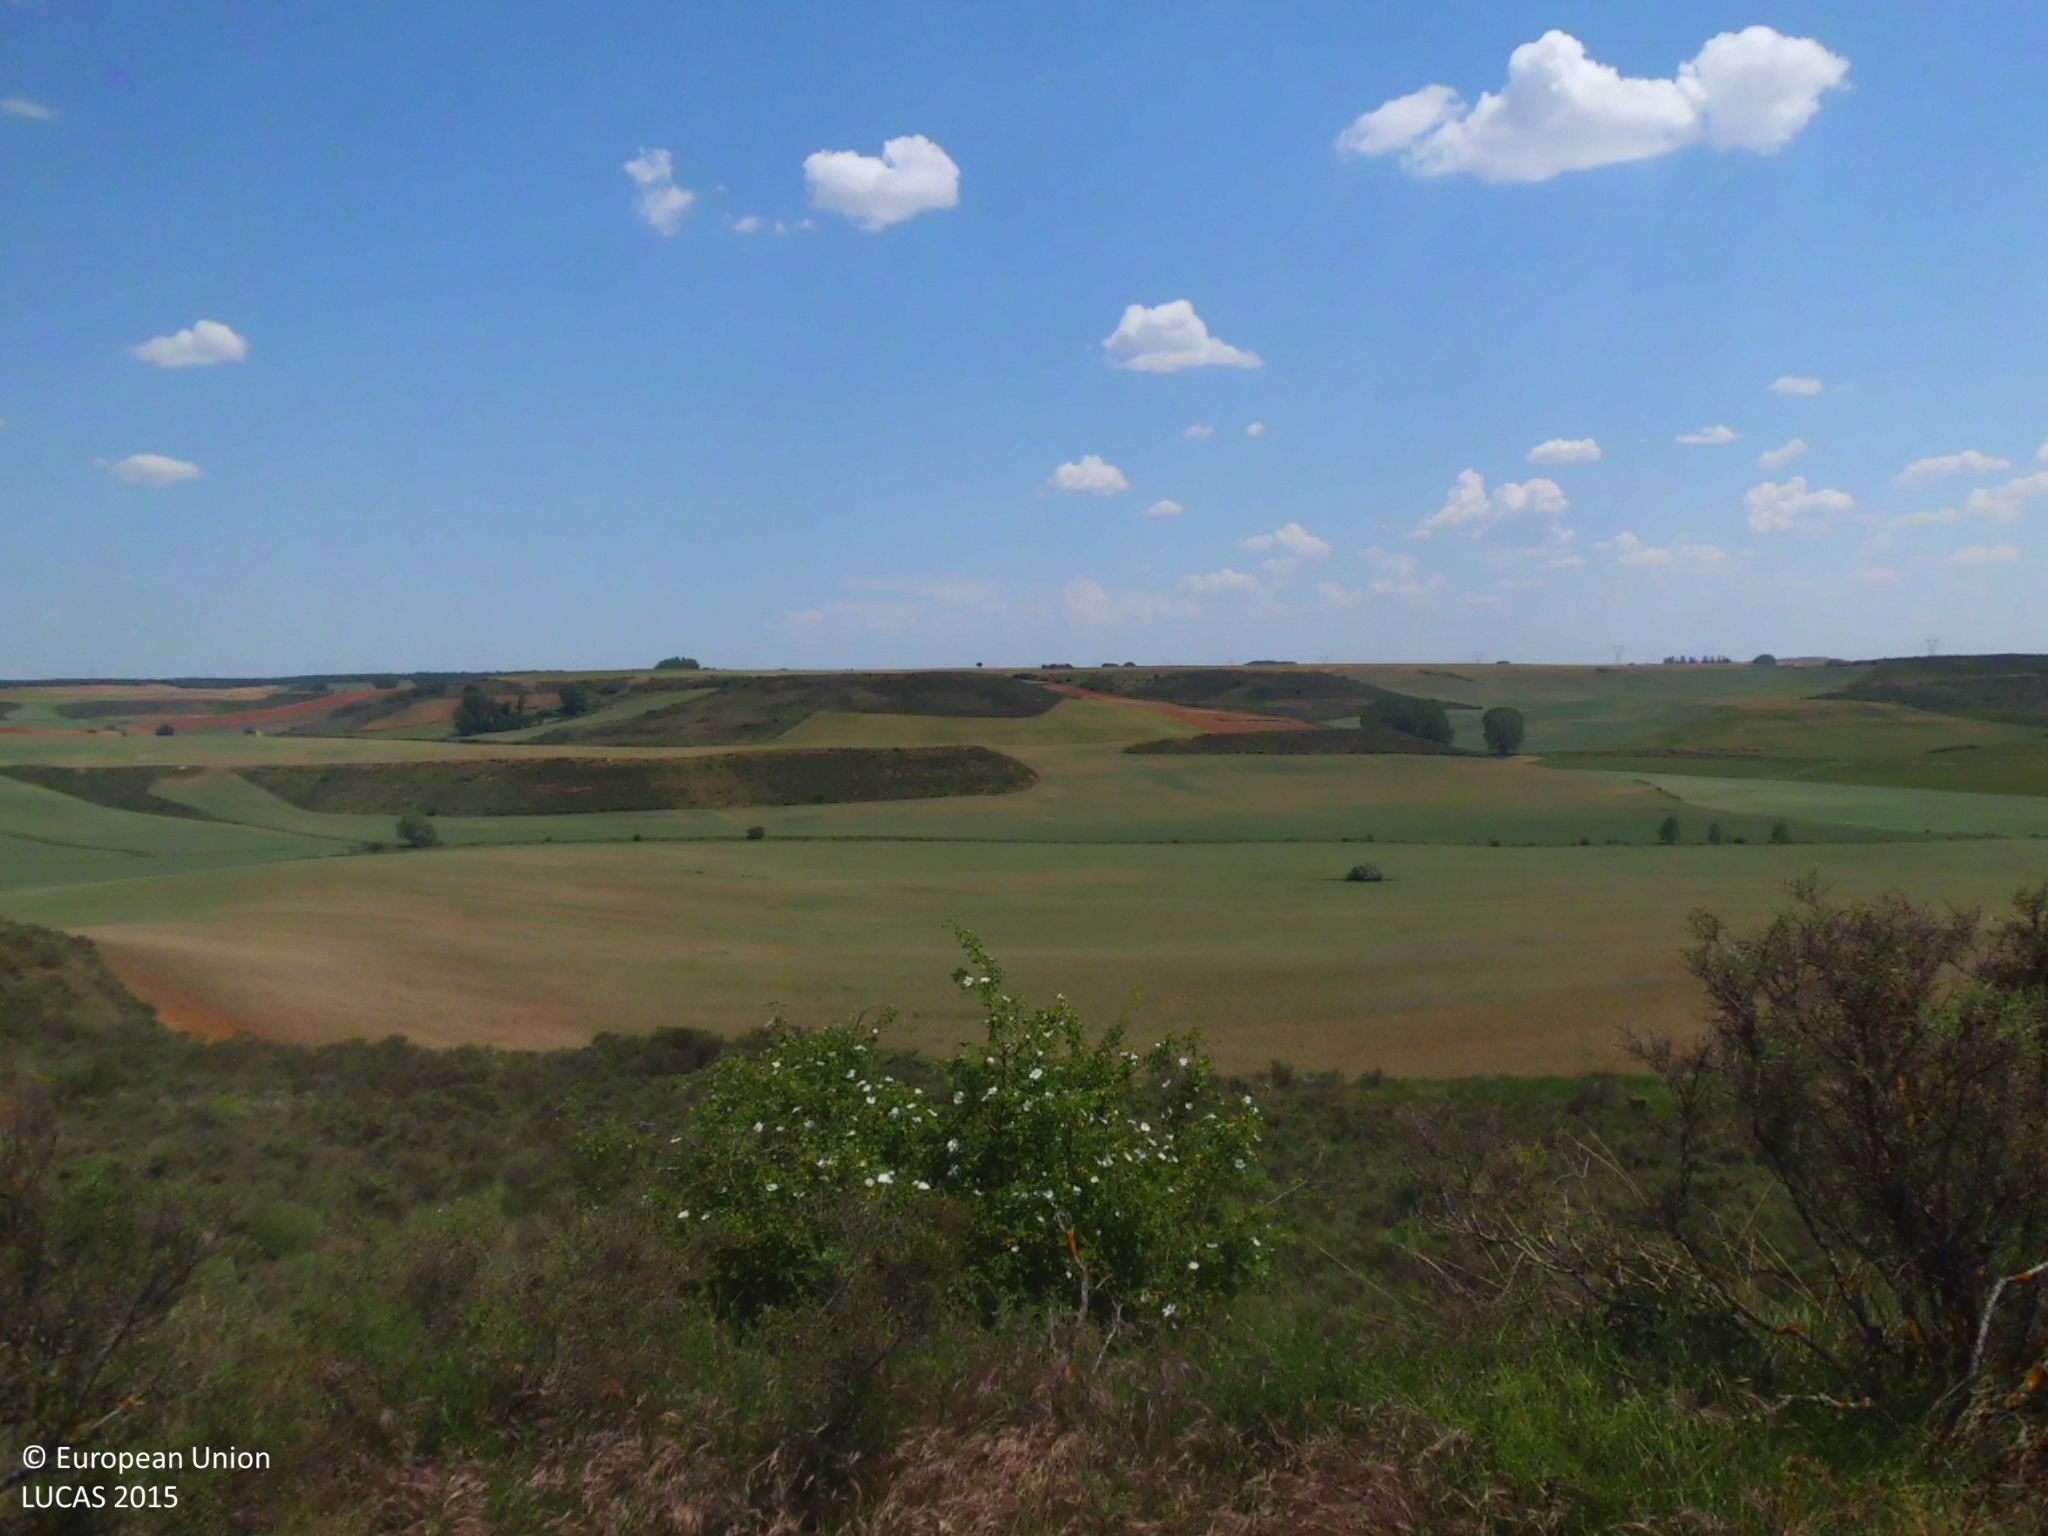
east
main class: Shrubland
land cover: Shrubland without tree cover
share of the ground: 50 - 75 %
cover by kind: shrubs 55 %, herbaceous plants 45 %
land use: Abandoned areas
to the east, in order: Shrubland without tree cover; Oats
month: June
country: ES
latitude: 42.5865
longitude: -4.2931
